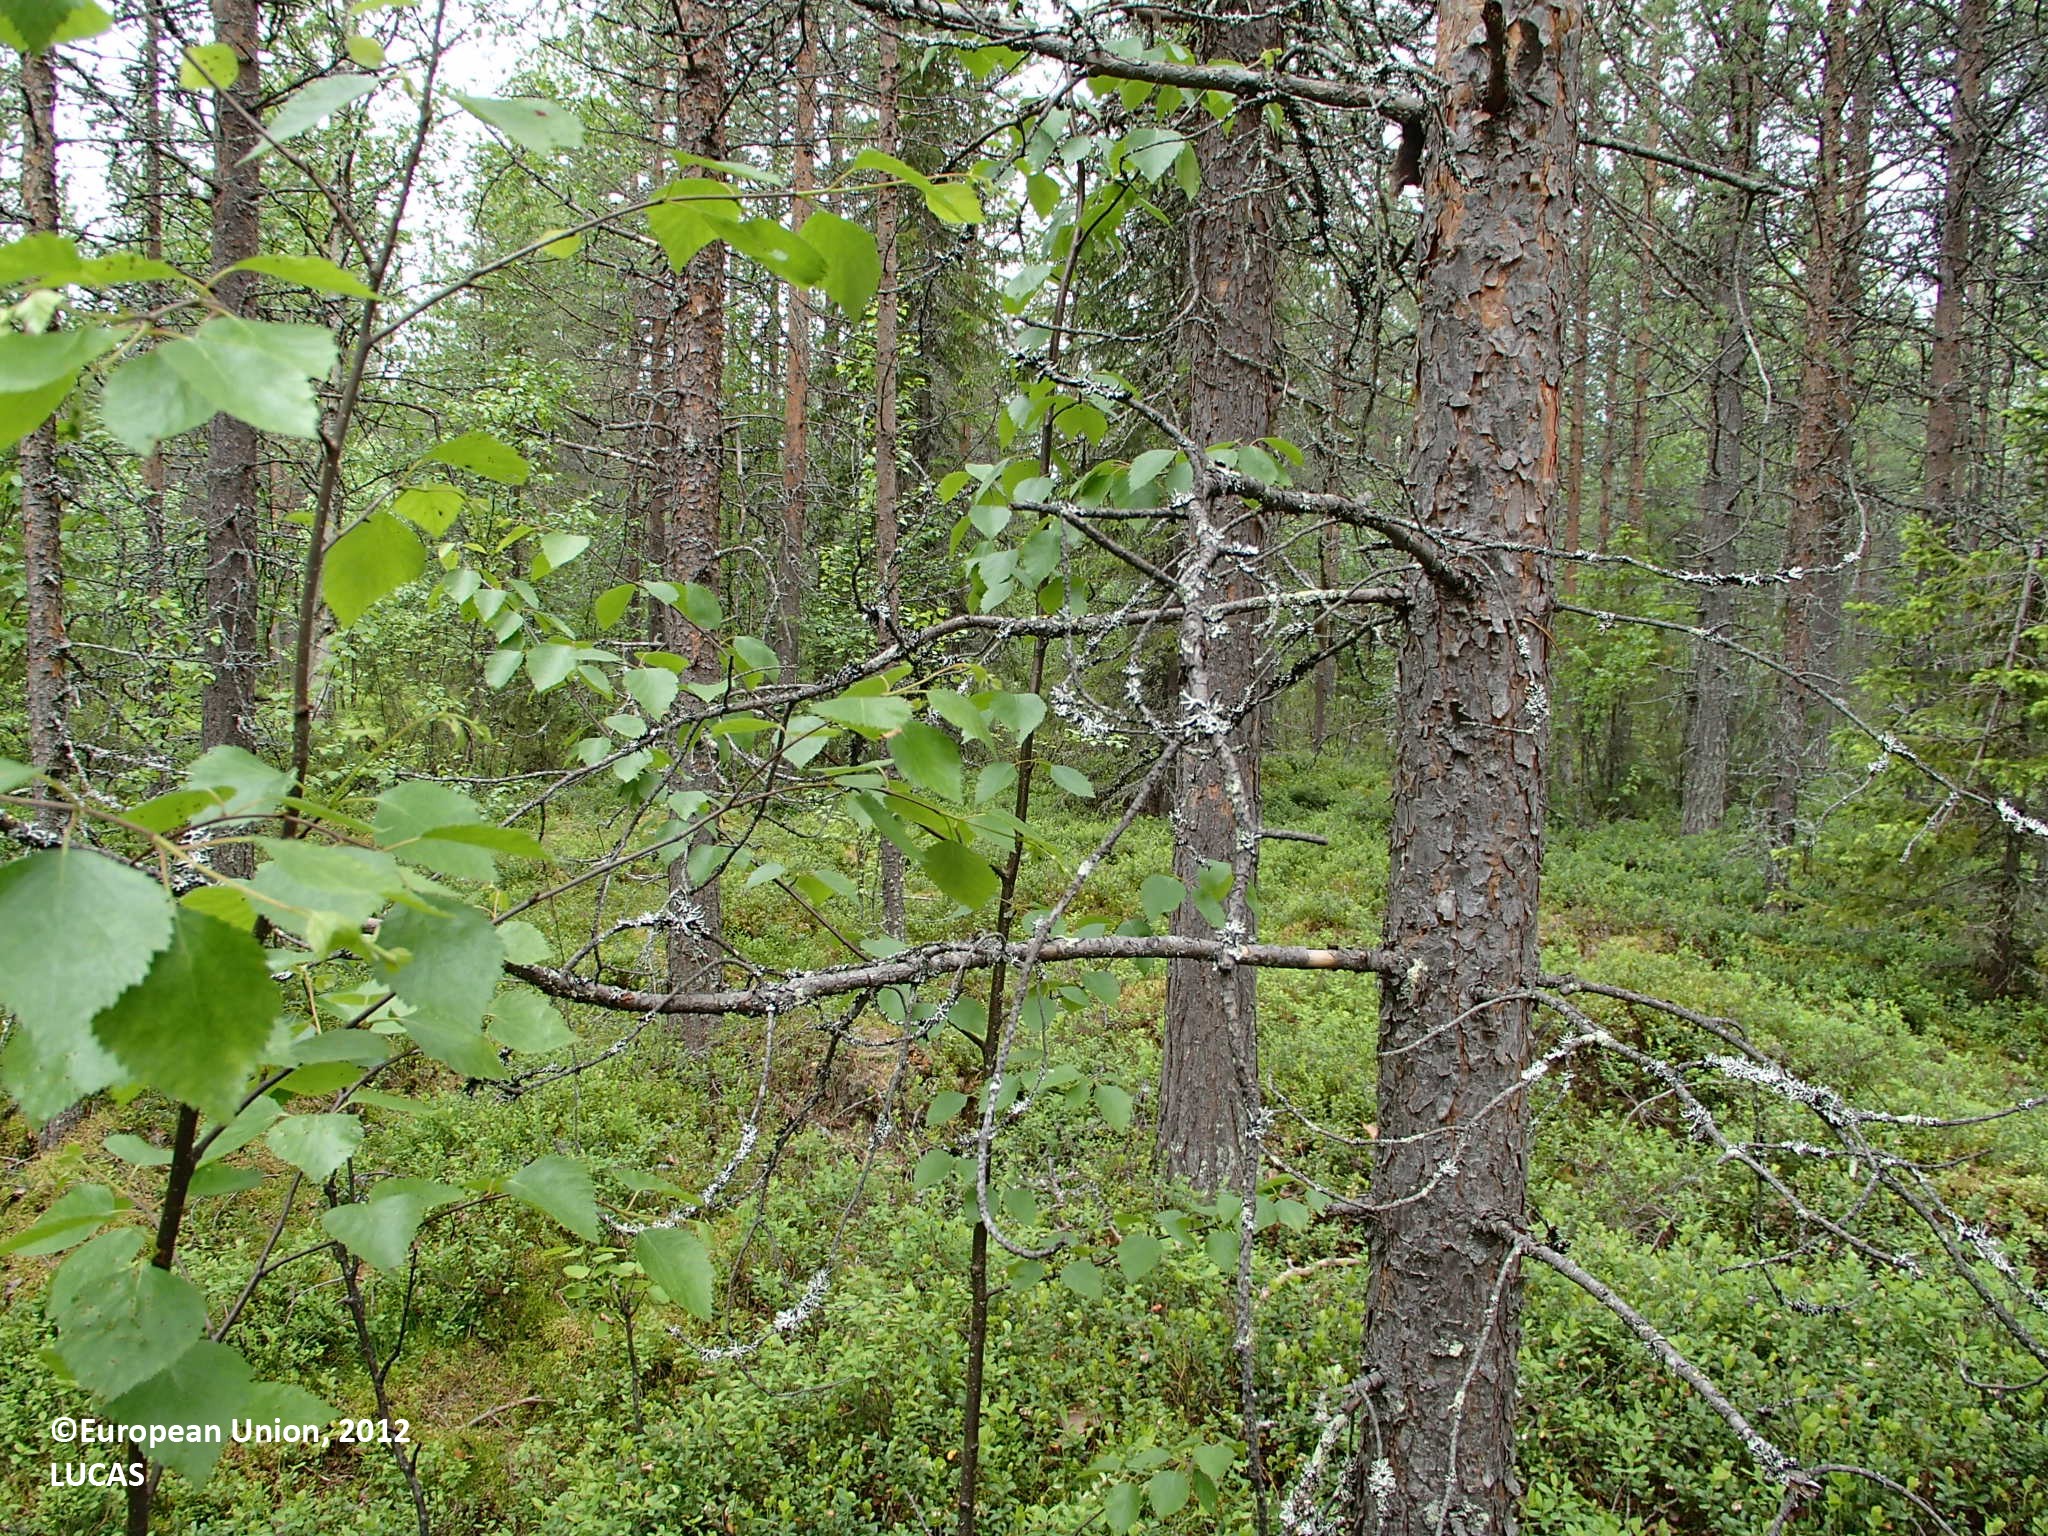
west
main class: Woodland
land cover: Pine dominated coniferous woodland
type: boreal forest
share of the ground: > 75 %
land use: Forestry
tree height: > 5 m
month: June
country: FI
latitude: 66.7870
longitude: 27.5027
